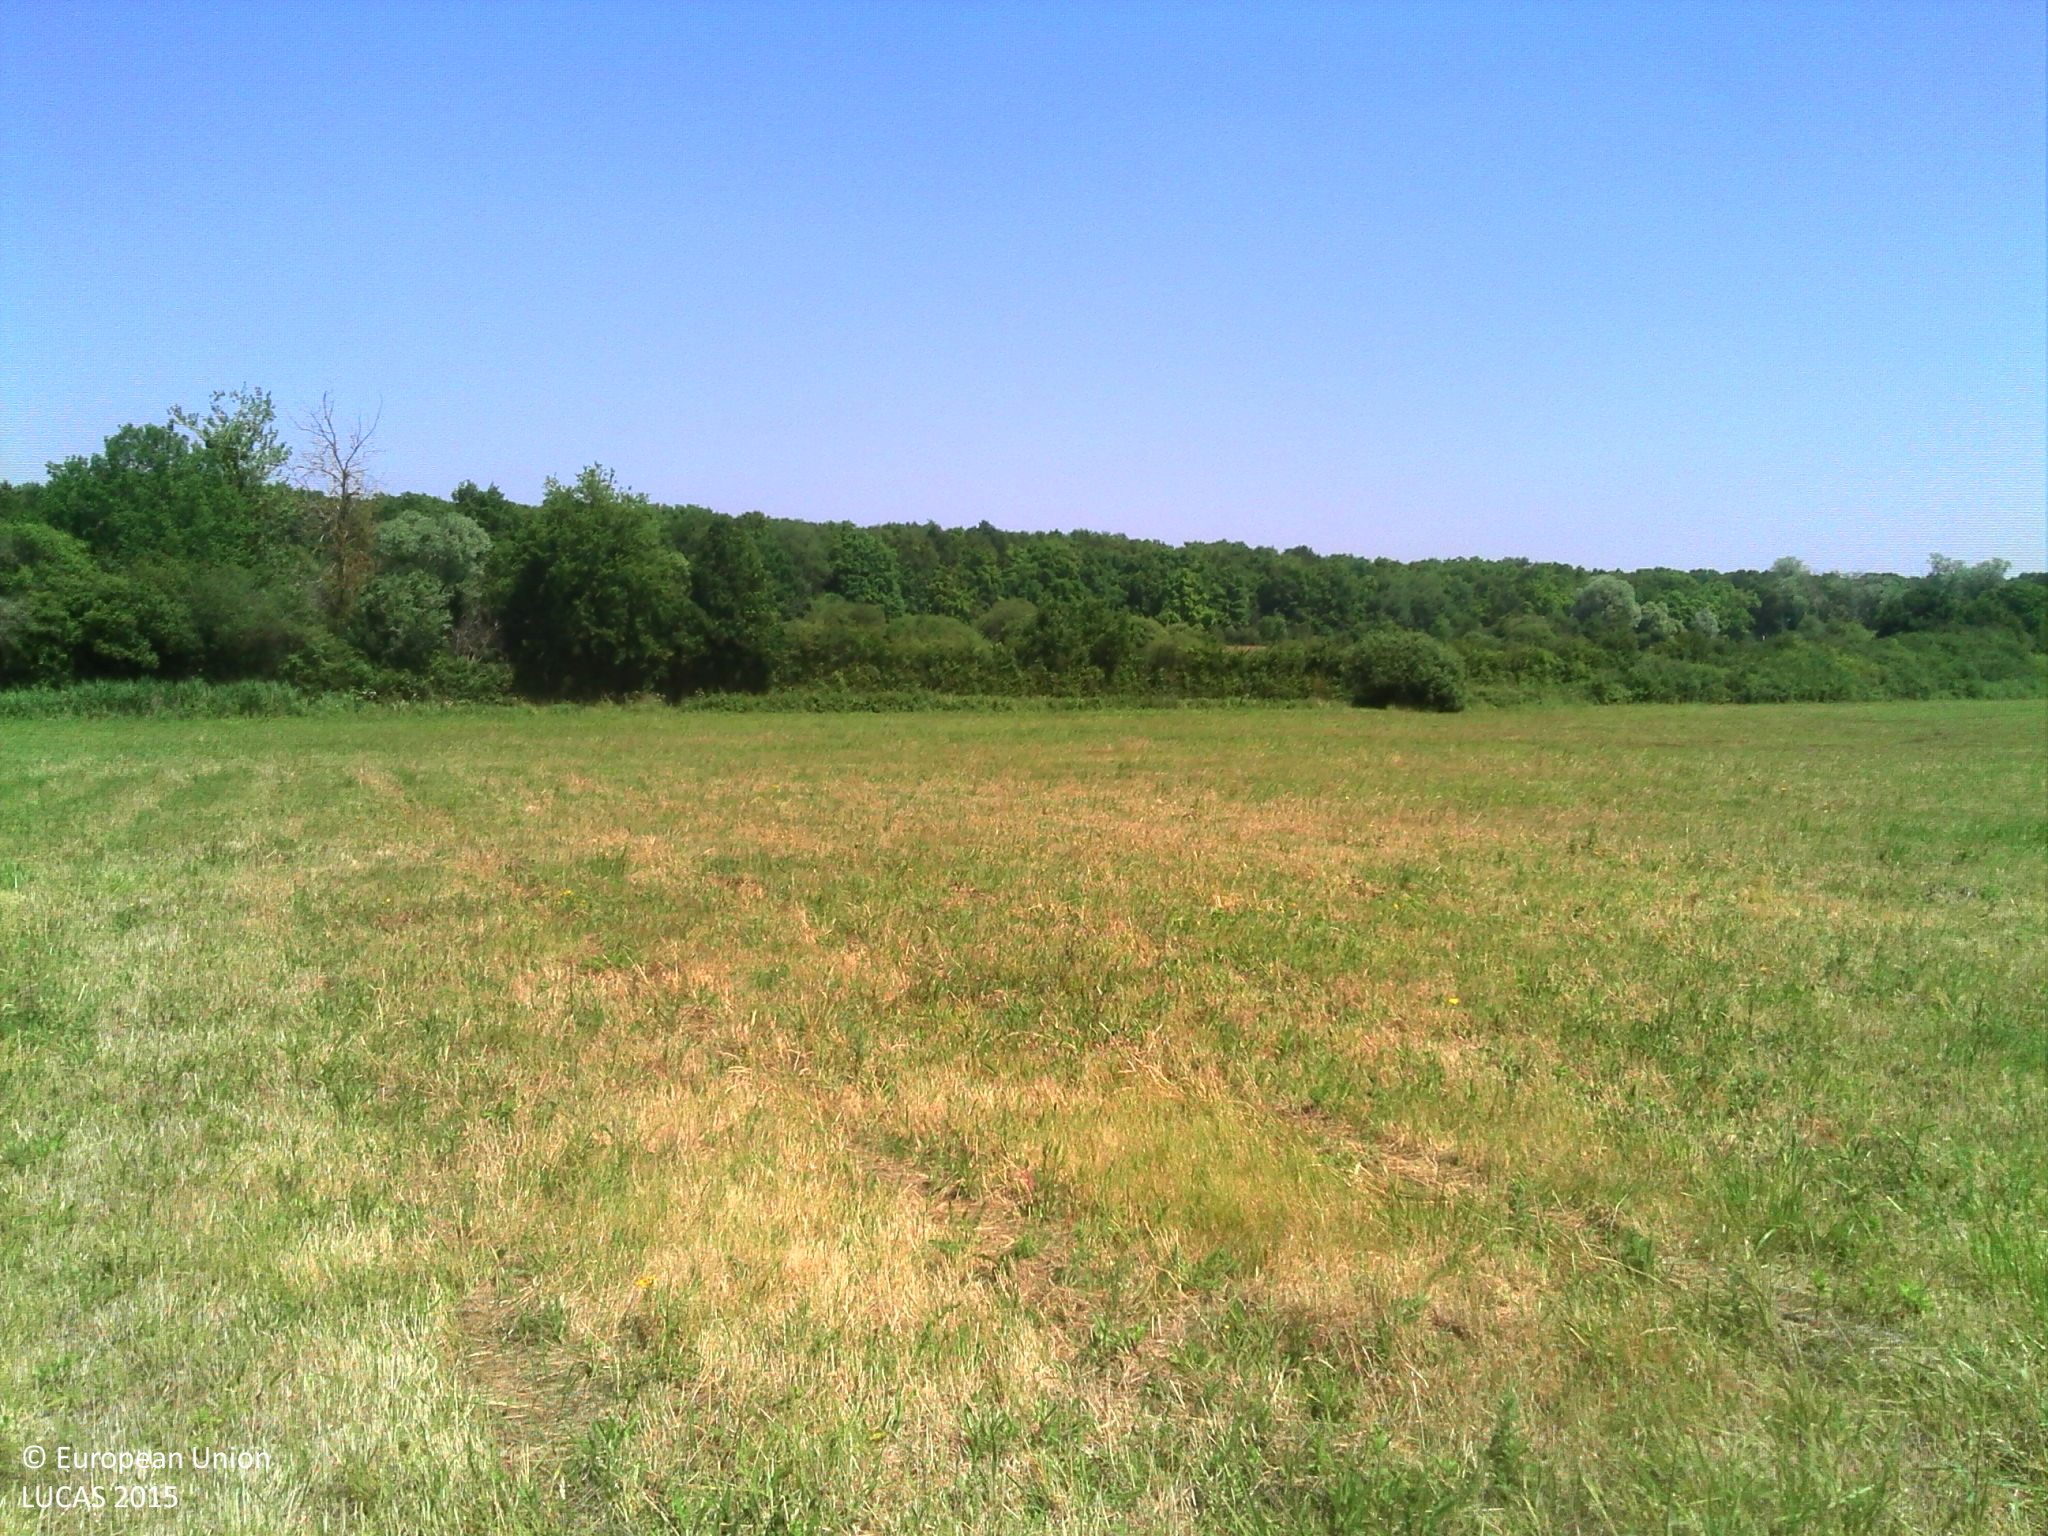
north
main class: Grassland
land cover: Grassland without tree/shrub cover
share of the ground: > 75 %
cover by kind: herbaceous plants 100 %
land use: Agriculture (excluding fallow land and kitchen gardens)
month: June
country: FR
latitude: 47.3271
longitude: 2.9153
